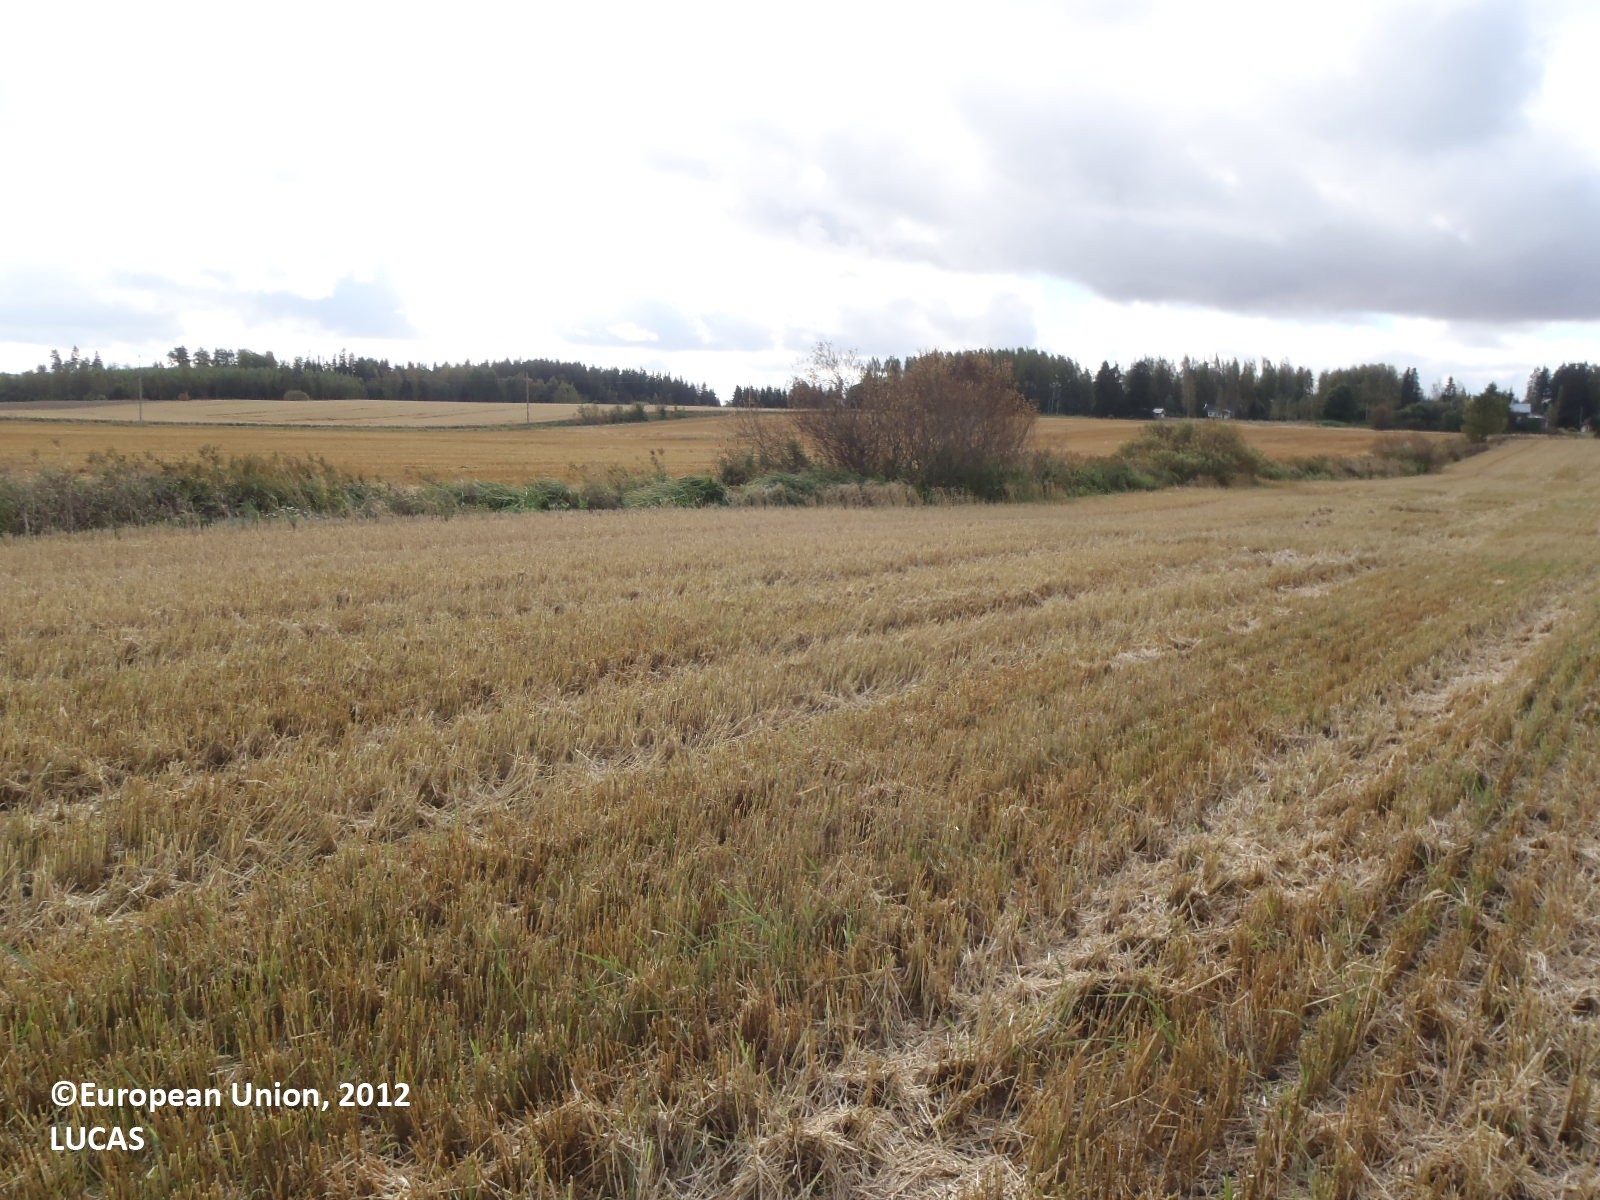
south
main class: Cropland
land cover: Barley
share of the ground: > 75 %
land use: Agriculture (excluding fallow land and kitchen gardens)
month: September
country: FI
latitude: 61.3350
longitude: 22.7575
